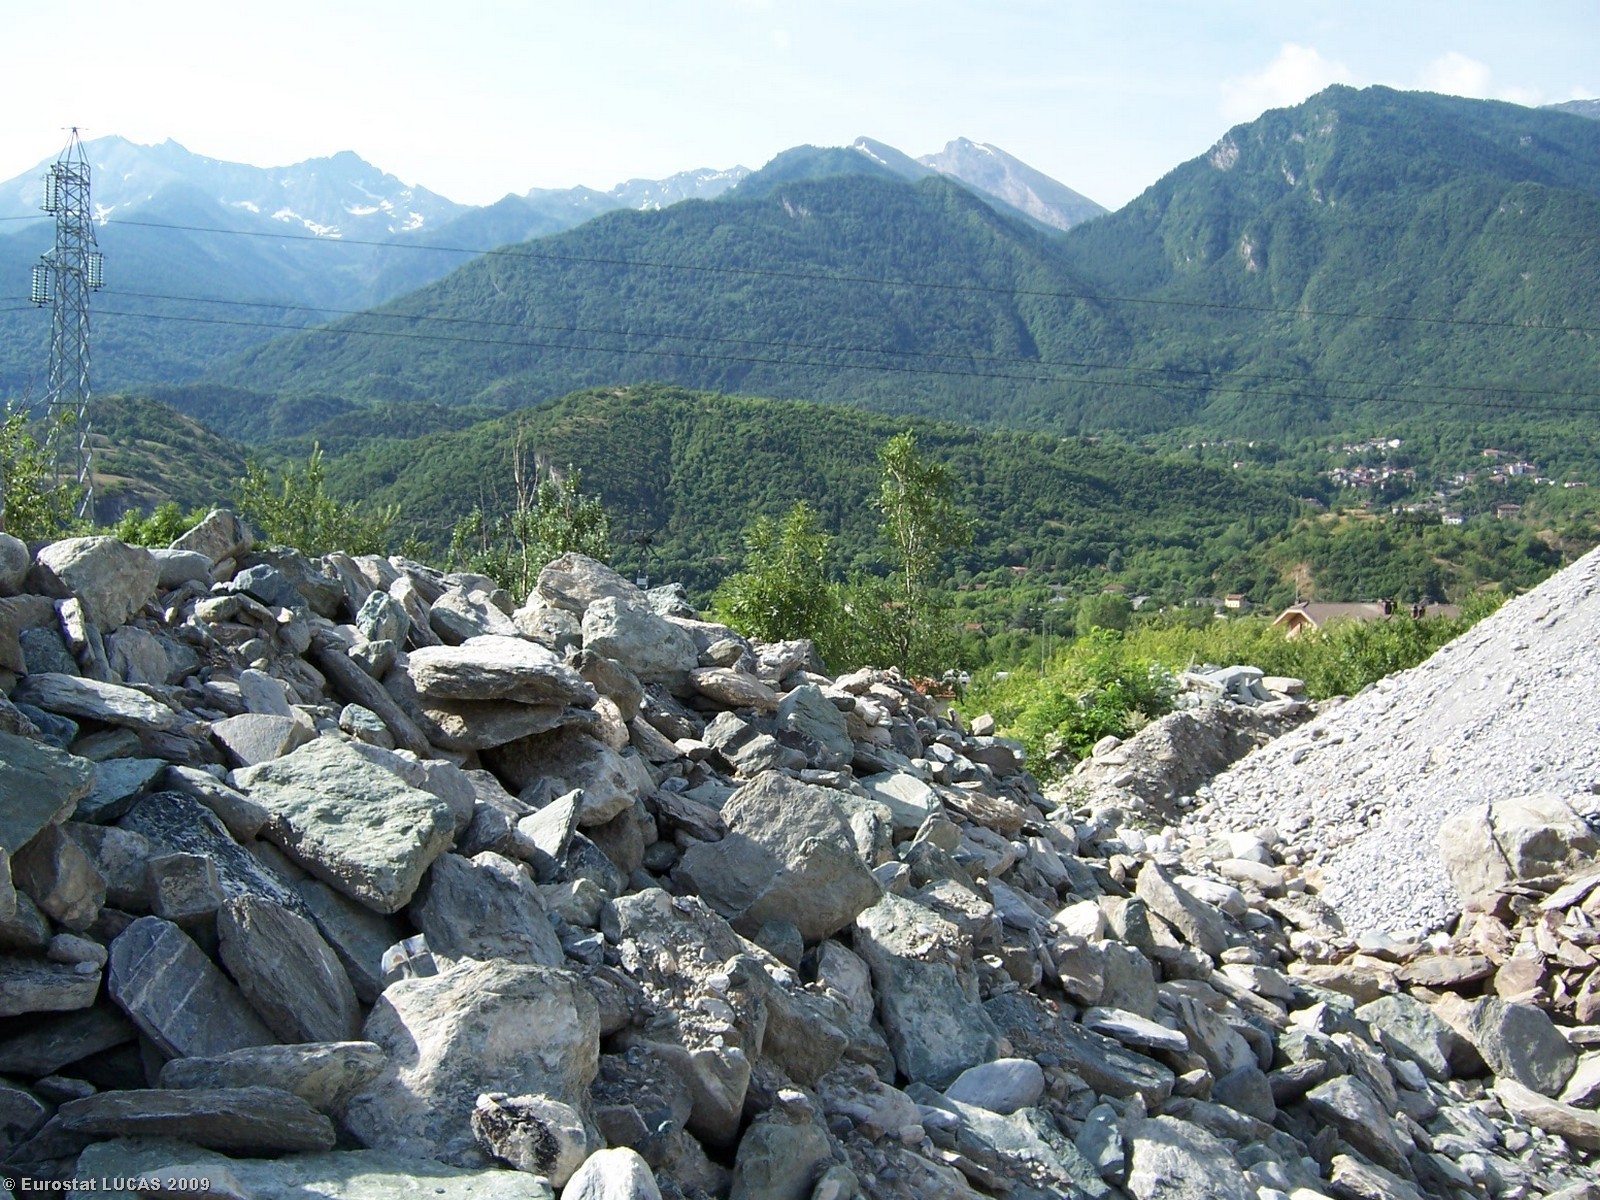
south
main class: Woodland
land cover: Broadleaved woodland
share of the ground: > 75 %
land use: Unused
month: July
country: IT
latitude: 45.1391
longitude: 7.0672
